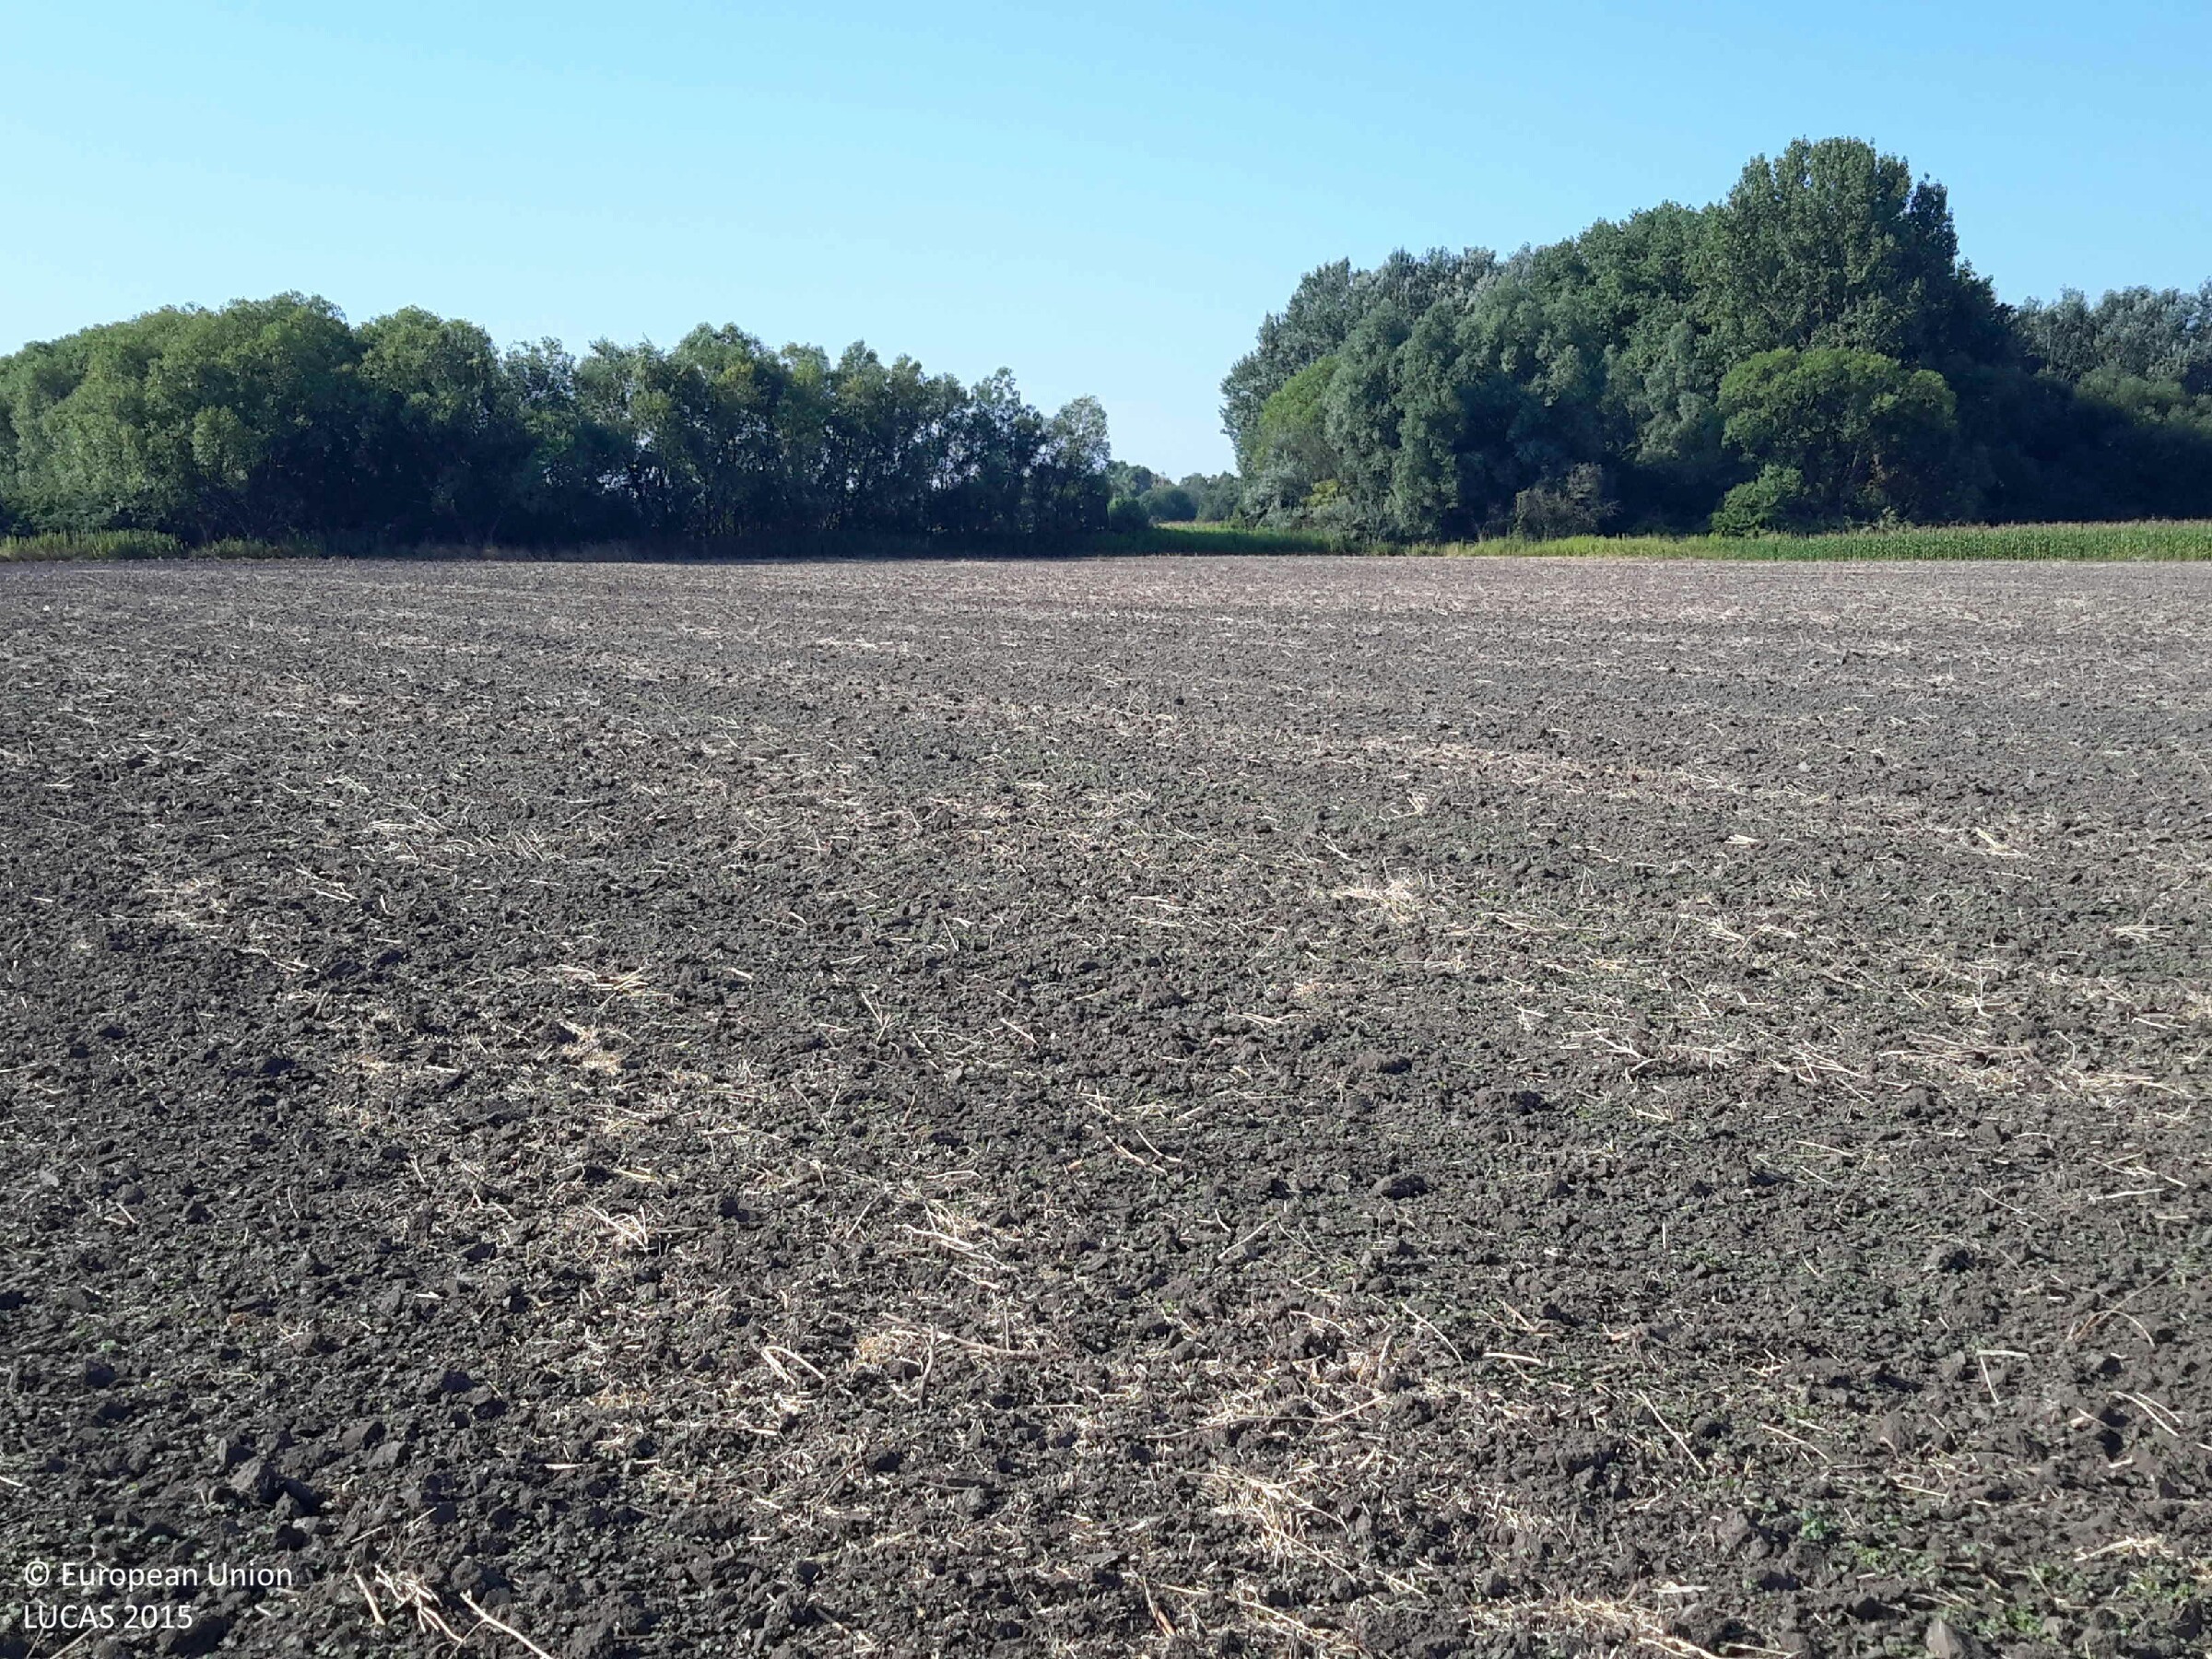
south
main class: Cropland
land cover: Rape and turnip rape
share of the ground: < 10 %
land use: Agriculture (excluding fallow land and kitchen gardens)
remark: Harvested field
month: July
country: HU
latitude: 47.5268
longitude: 17.8597
